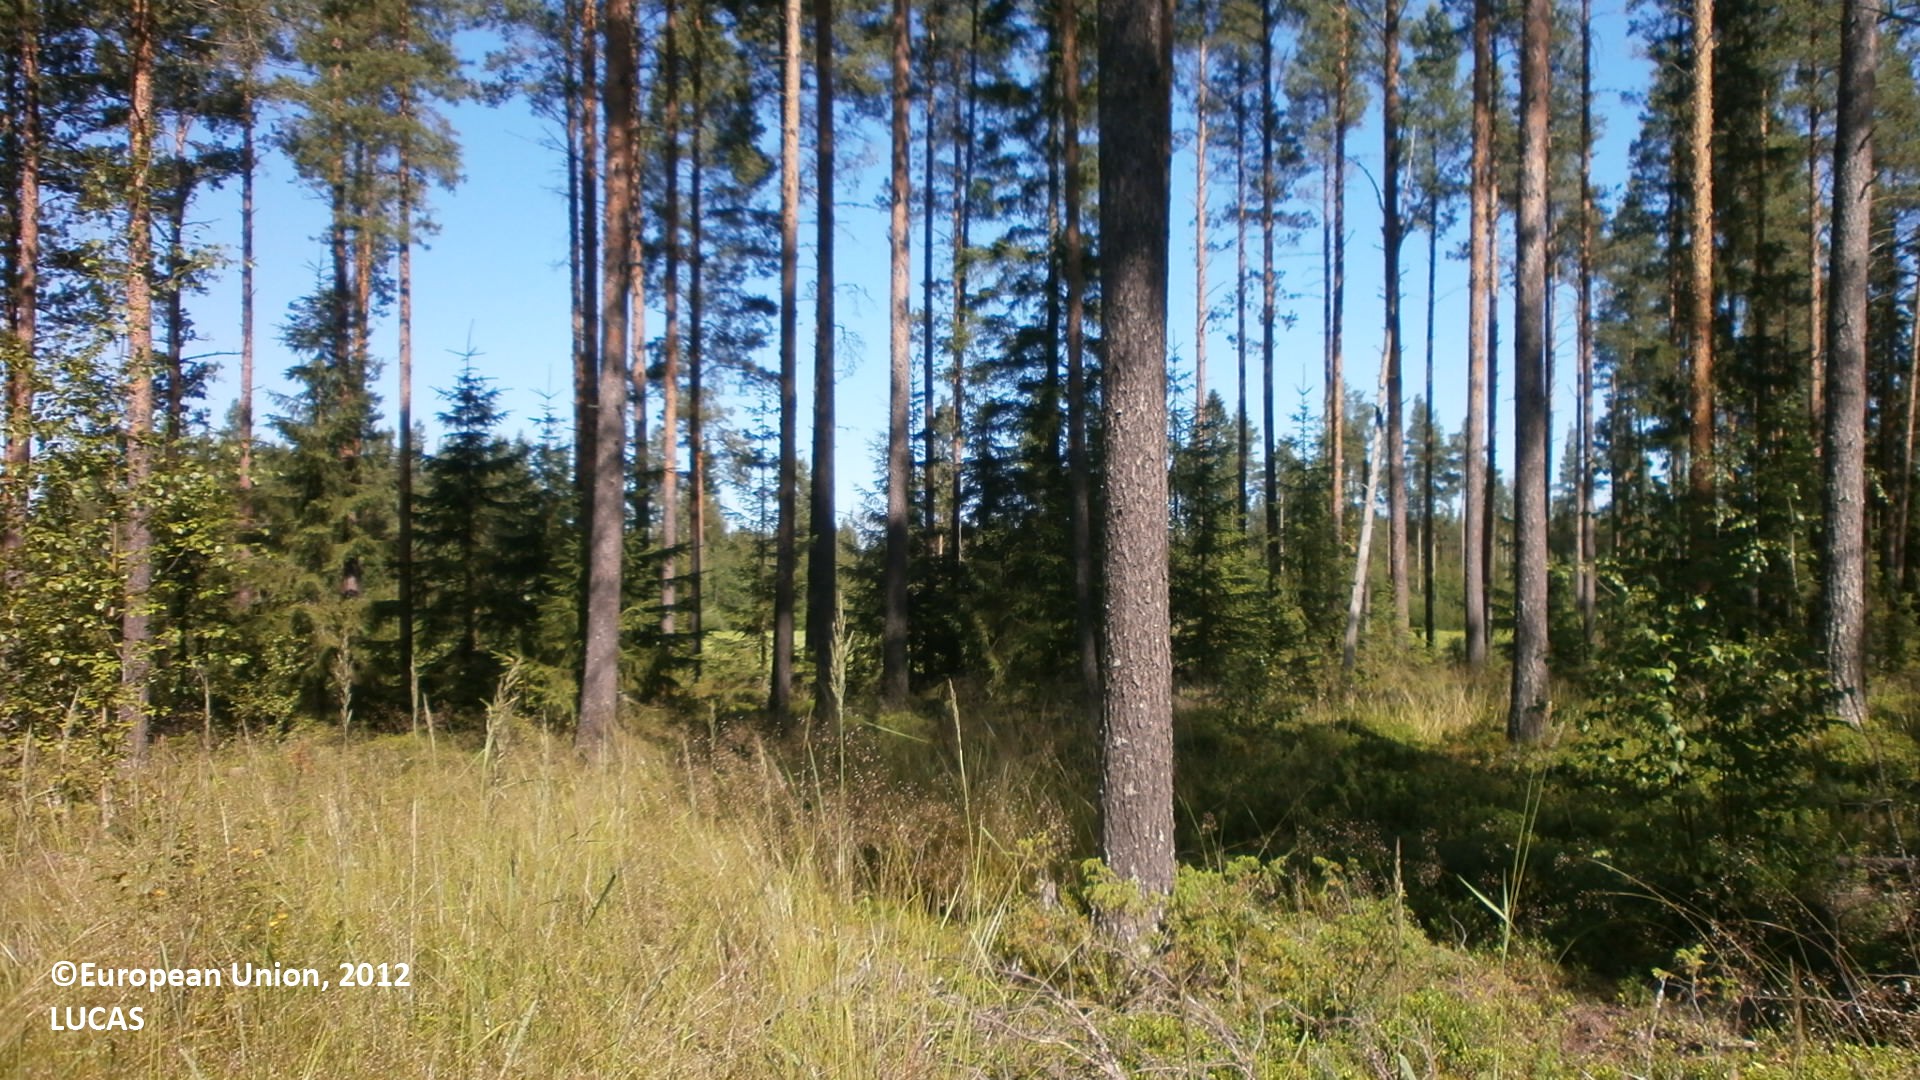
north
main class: Woodland
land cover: Pine dominated coniferous woodland
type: boreal forest
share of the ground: 50 - 75 %
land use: Forestry
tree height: > 5 m
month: July
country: FI
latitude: 64.1110
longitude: 24.3368
